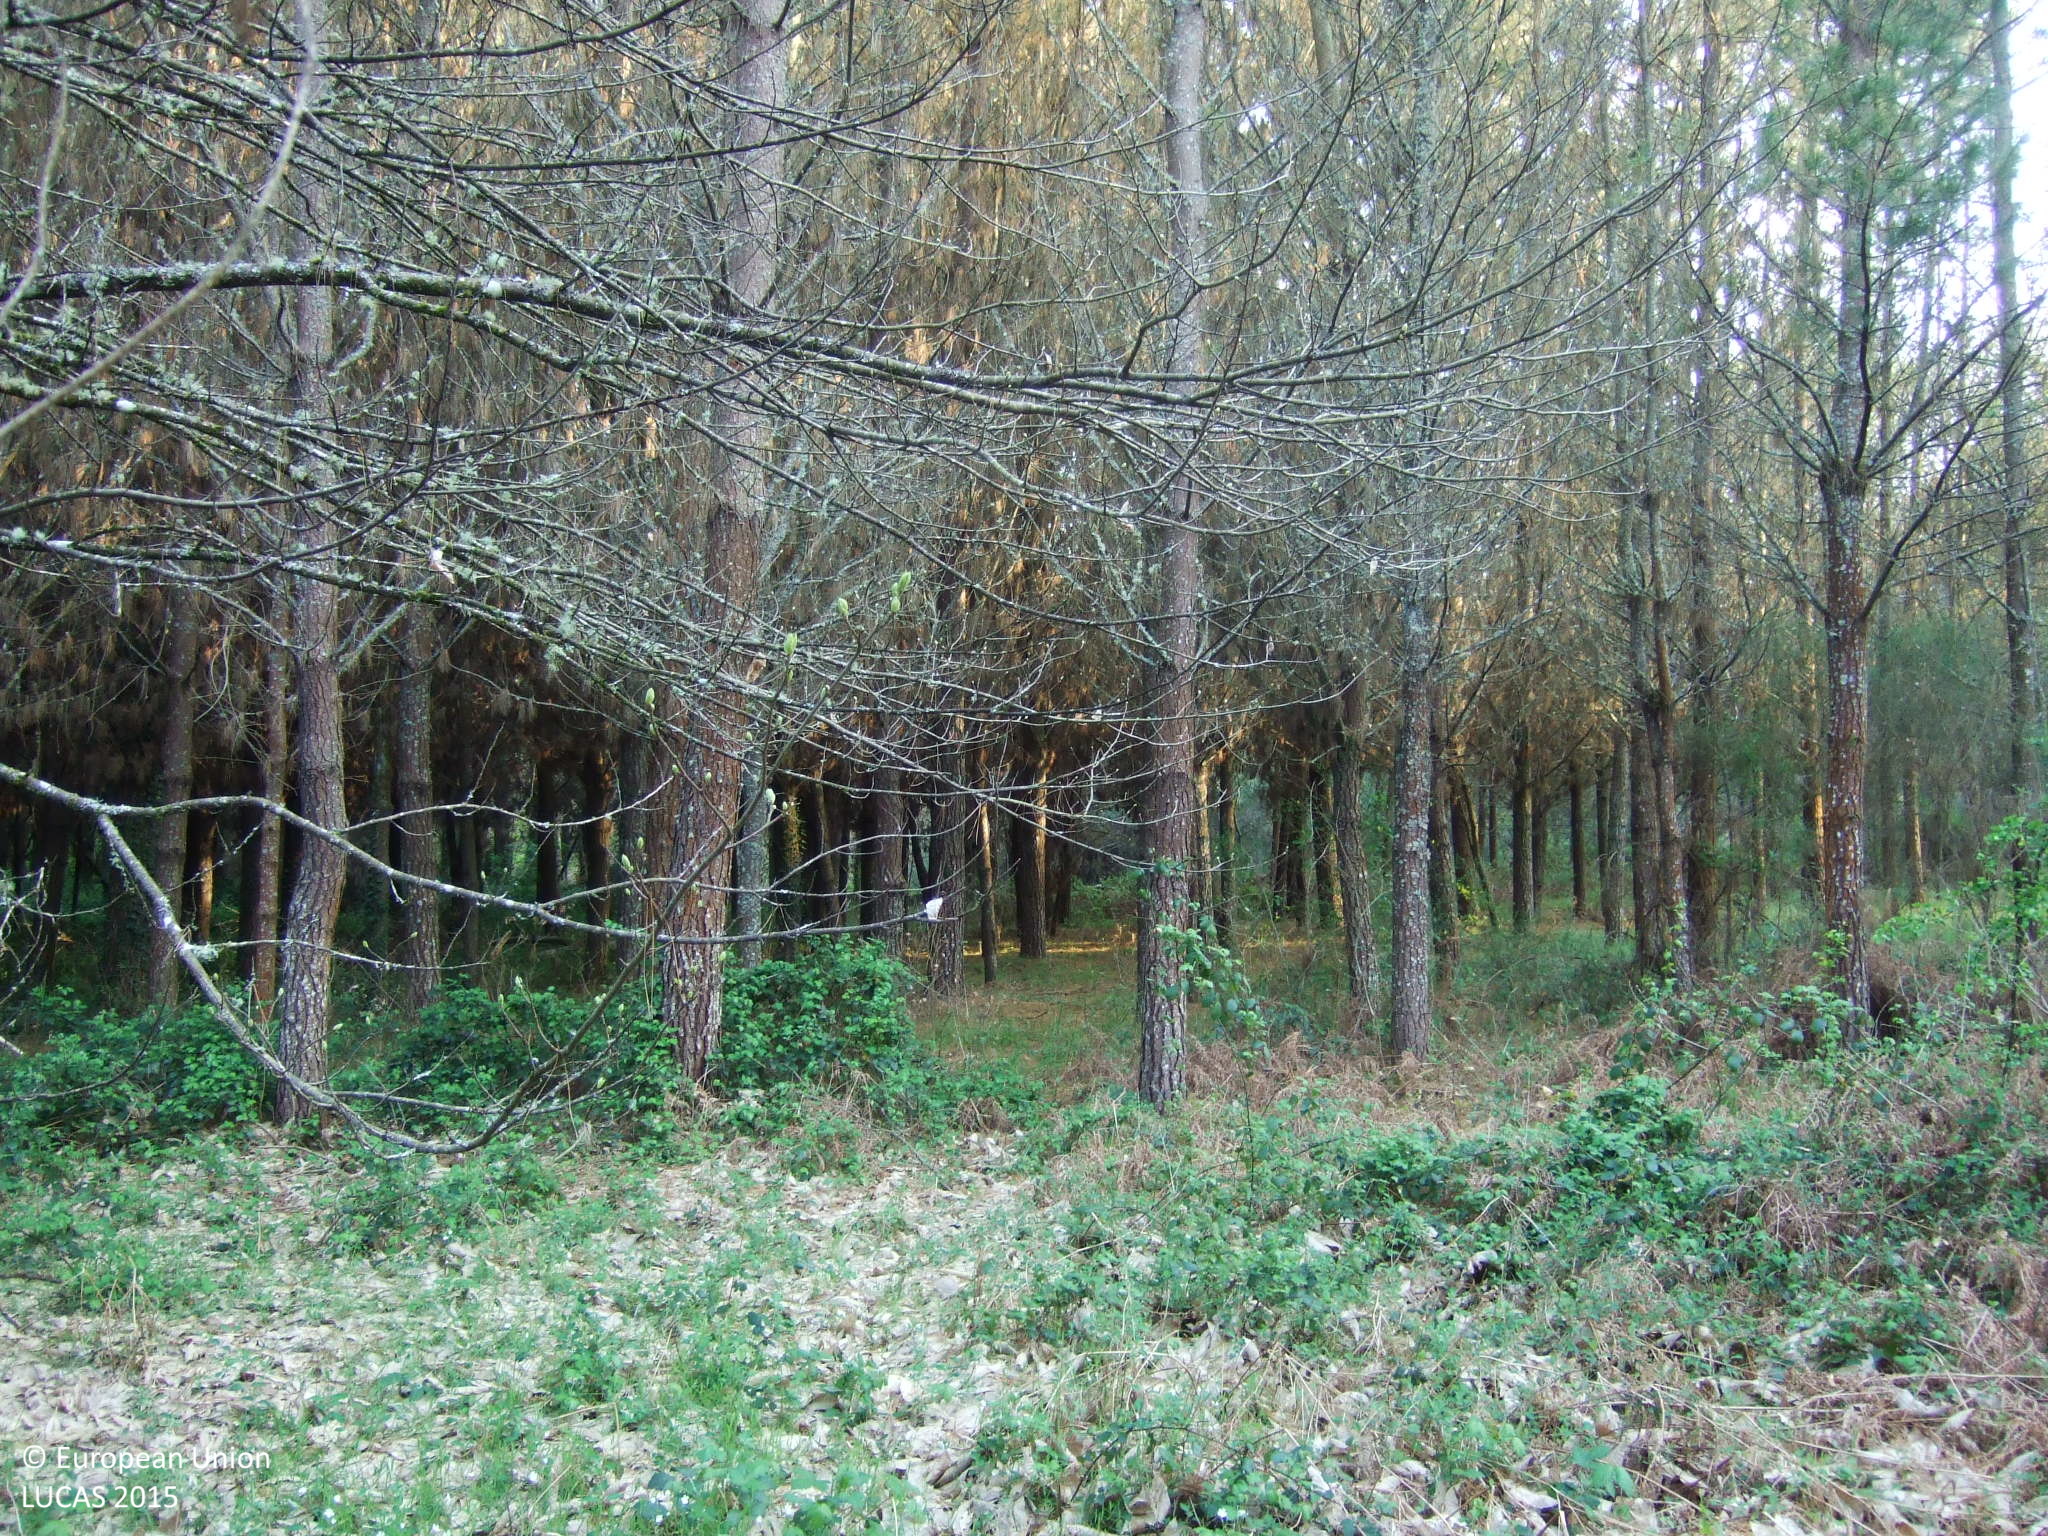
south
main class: Woodland
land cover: Pine dominated coniferous woodland
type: exotic forest
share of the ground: 25 - 50 %
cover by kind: coniferous forest trees 50 %, herbaceous plants 30 %, shrubs 20 %
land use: Forestry
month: April
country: ES
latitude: 43.0705
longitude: -7.6040
